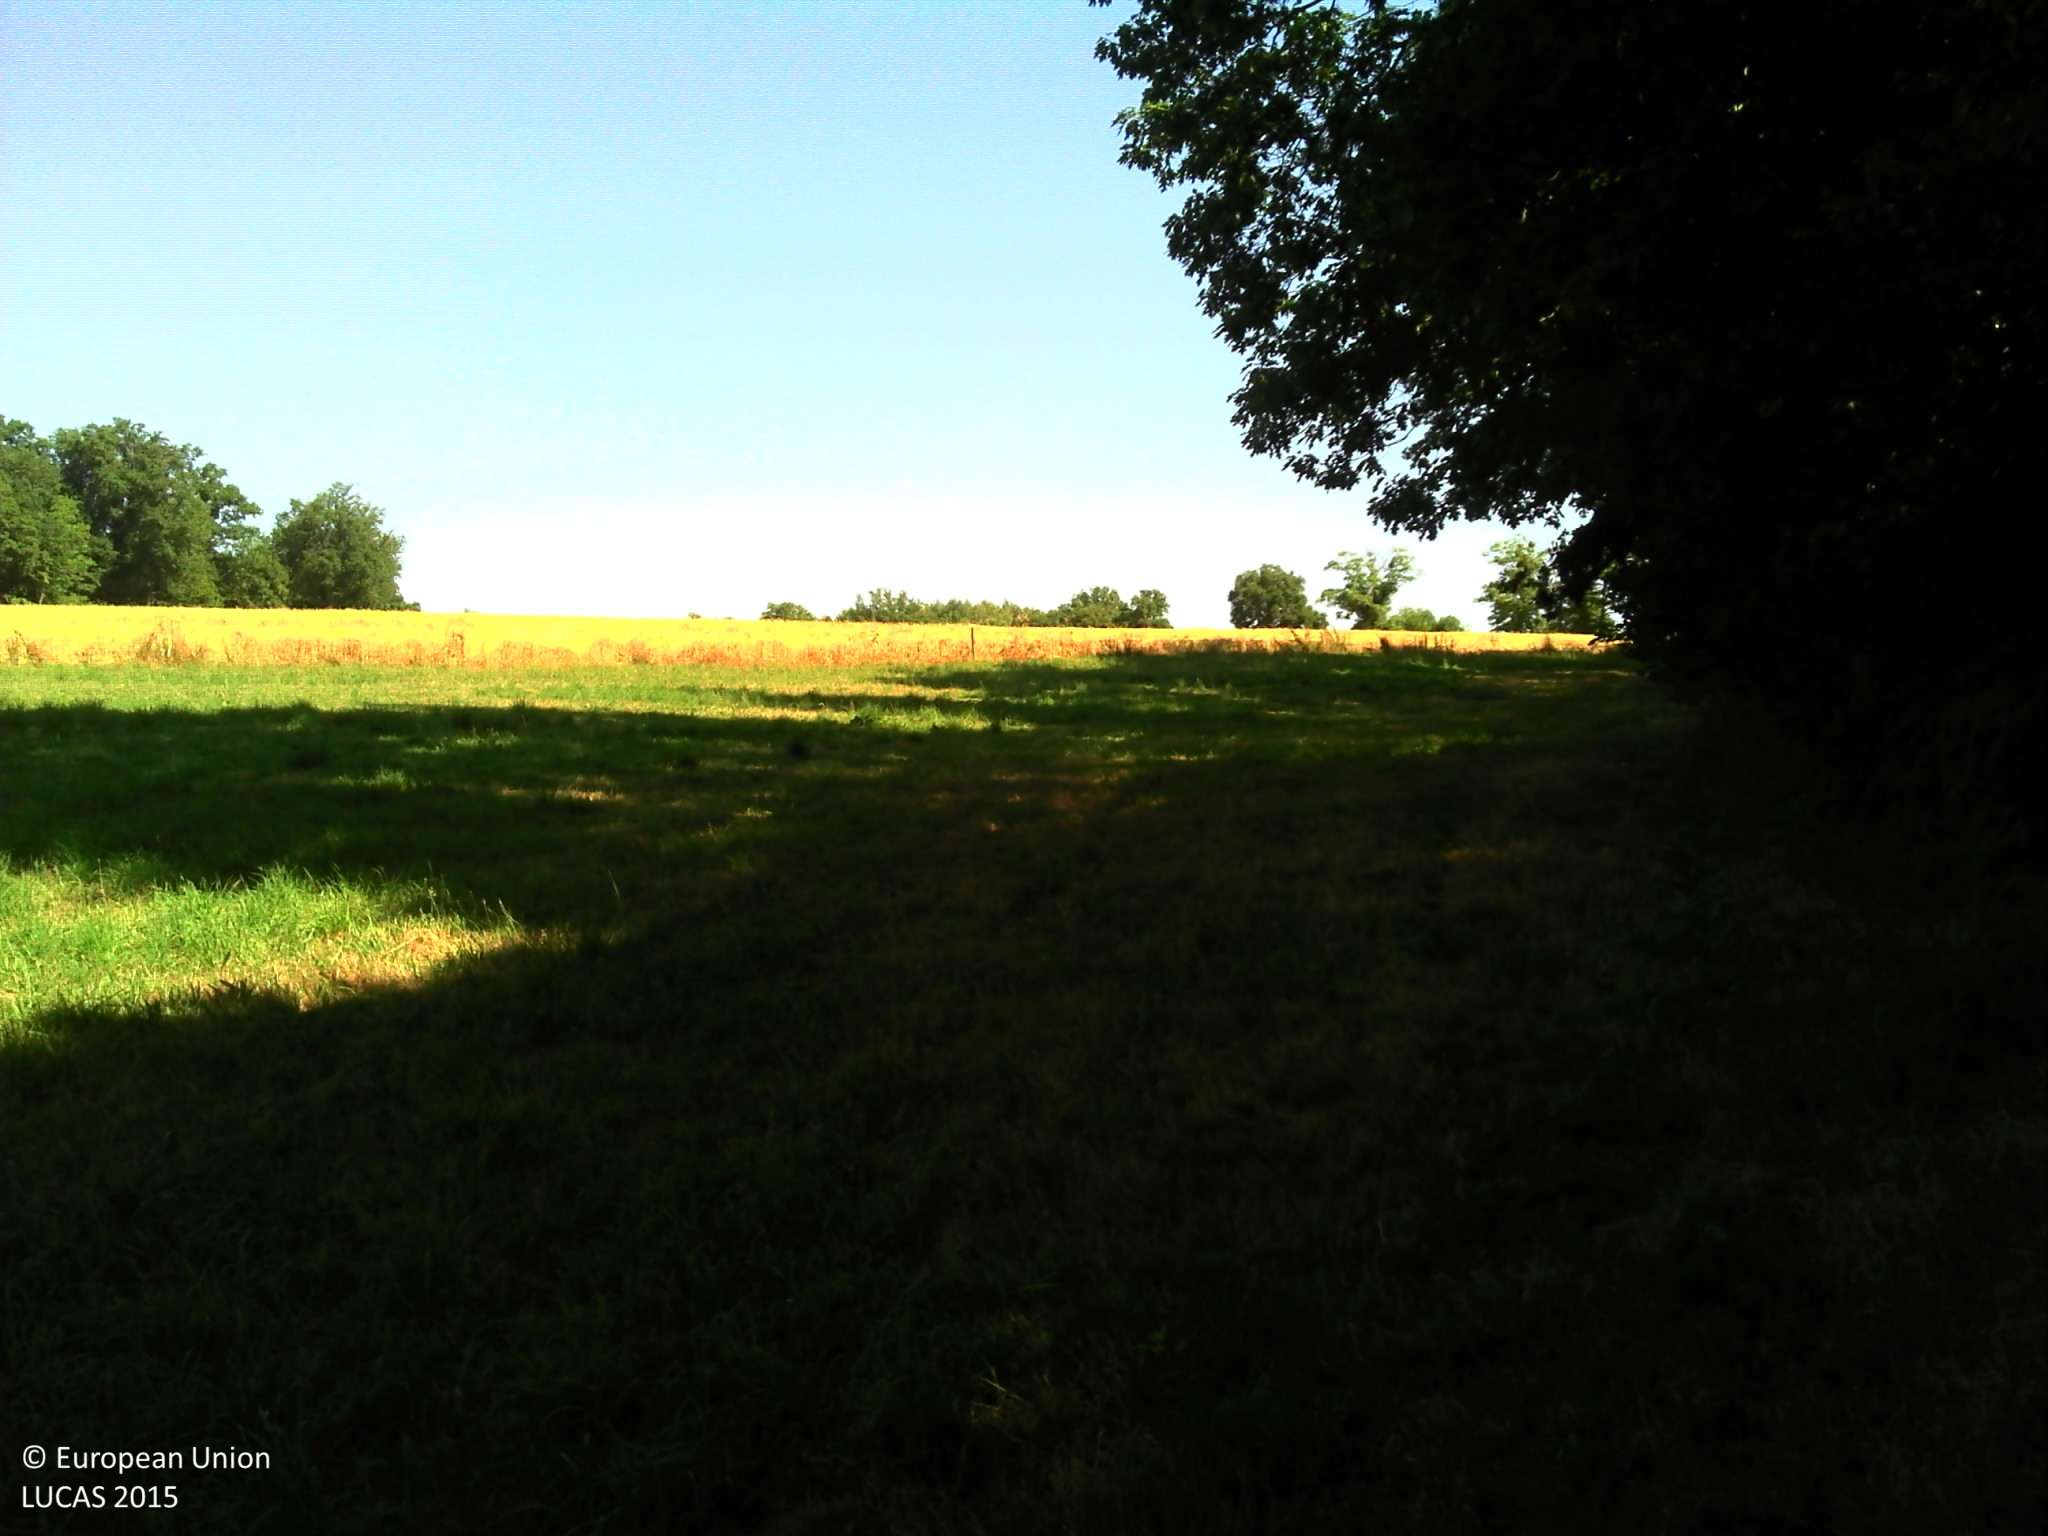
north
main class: Grassland
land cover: Grassland without tree/shrub cover
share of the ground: > 75 %
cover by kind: herbaceous plants 95 %
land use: Agriculture (excluding fallow land and kitchen gardens)
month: July
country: FR
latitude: 45.7754
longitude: 1.2587
